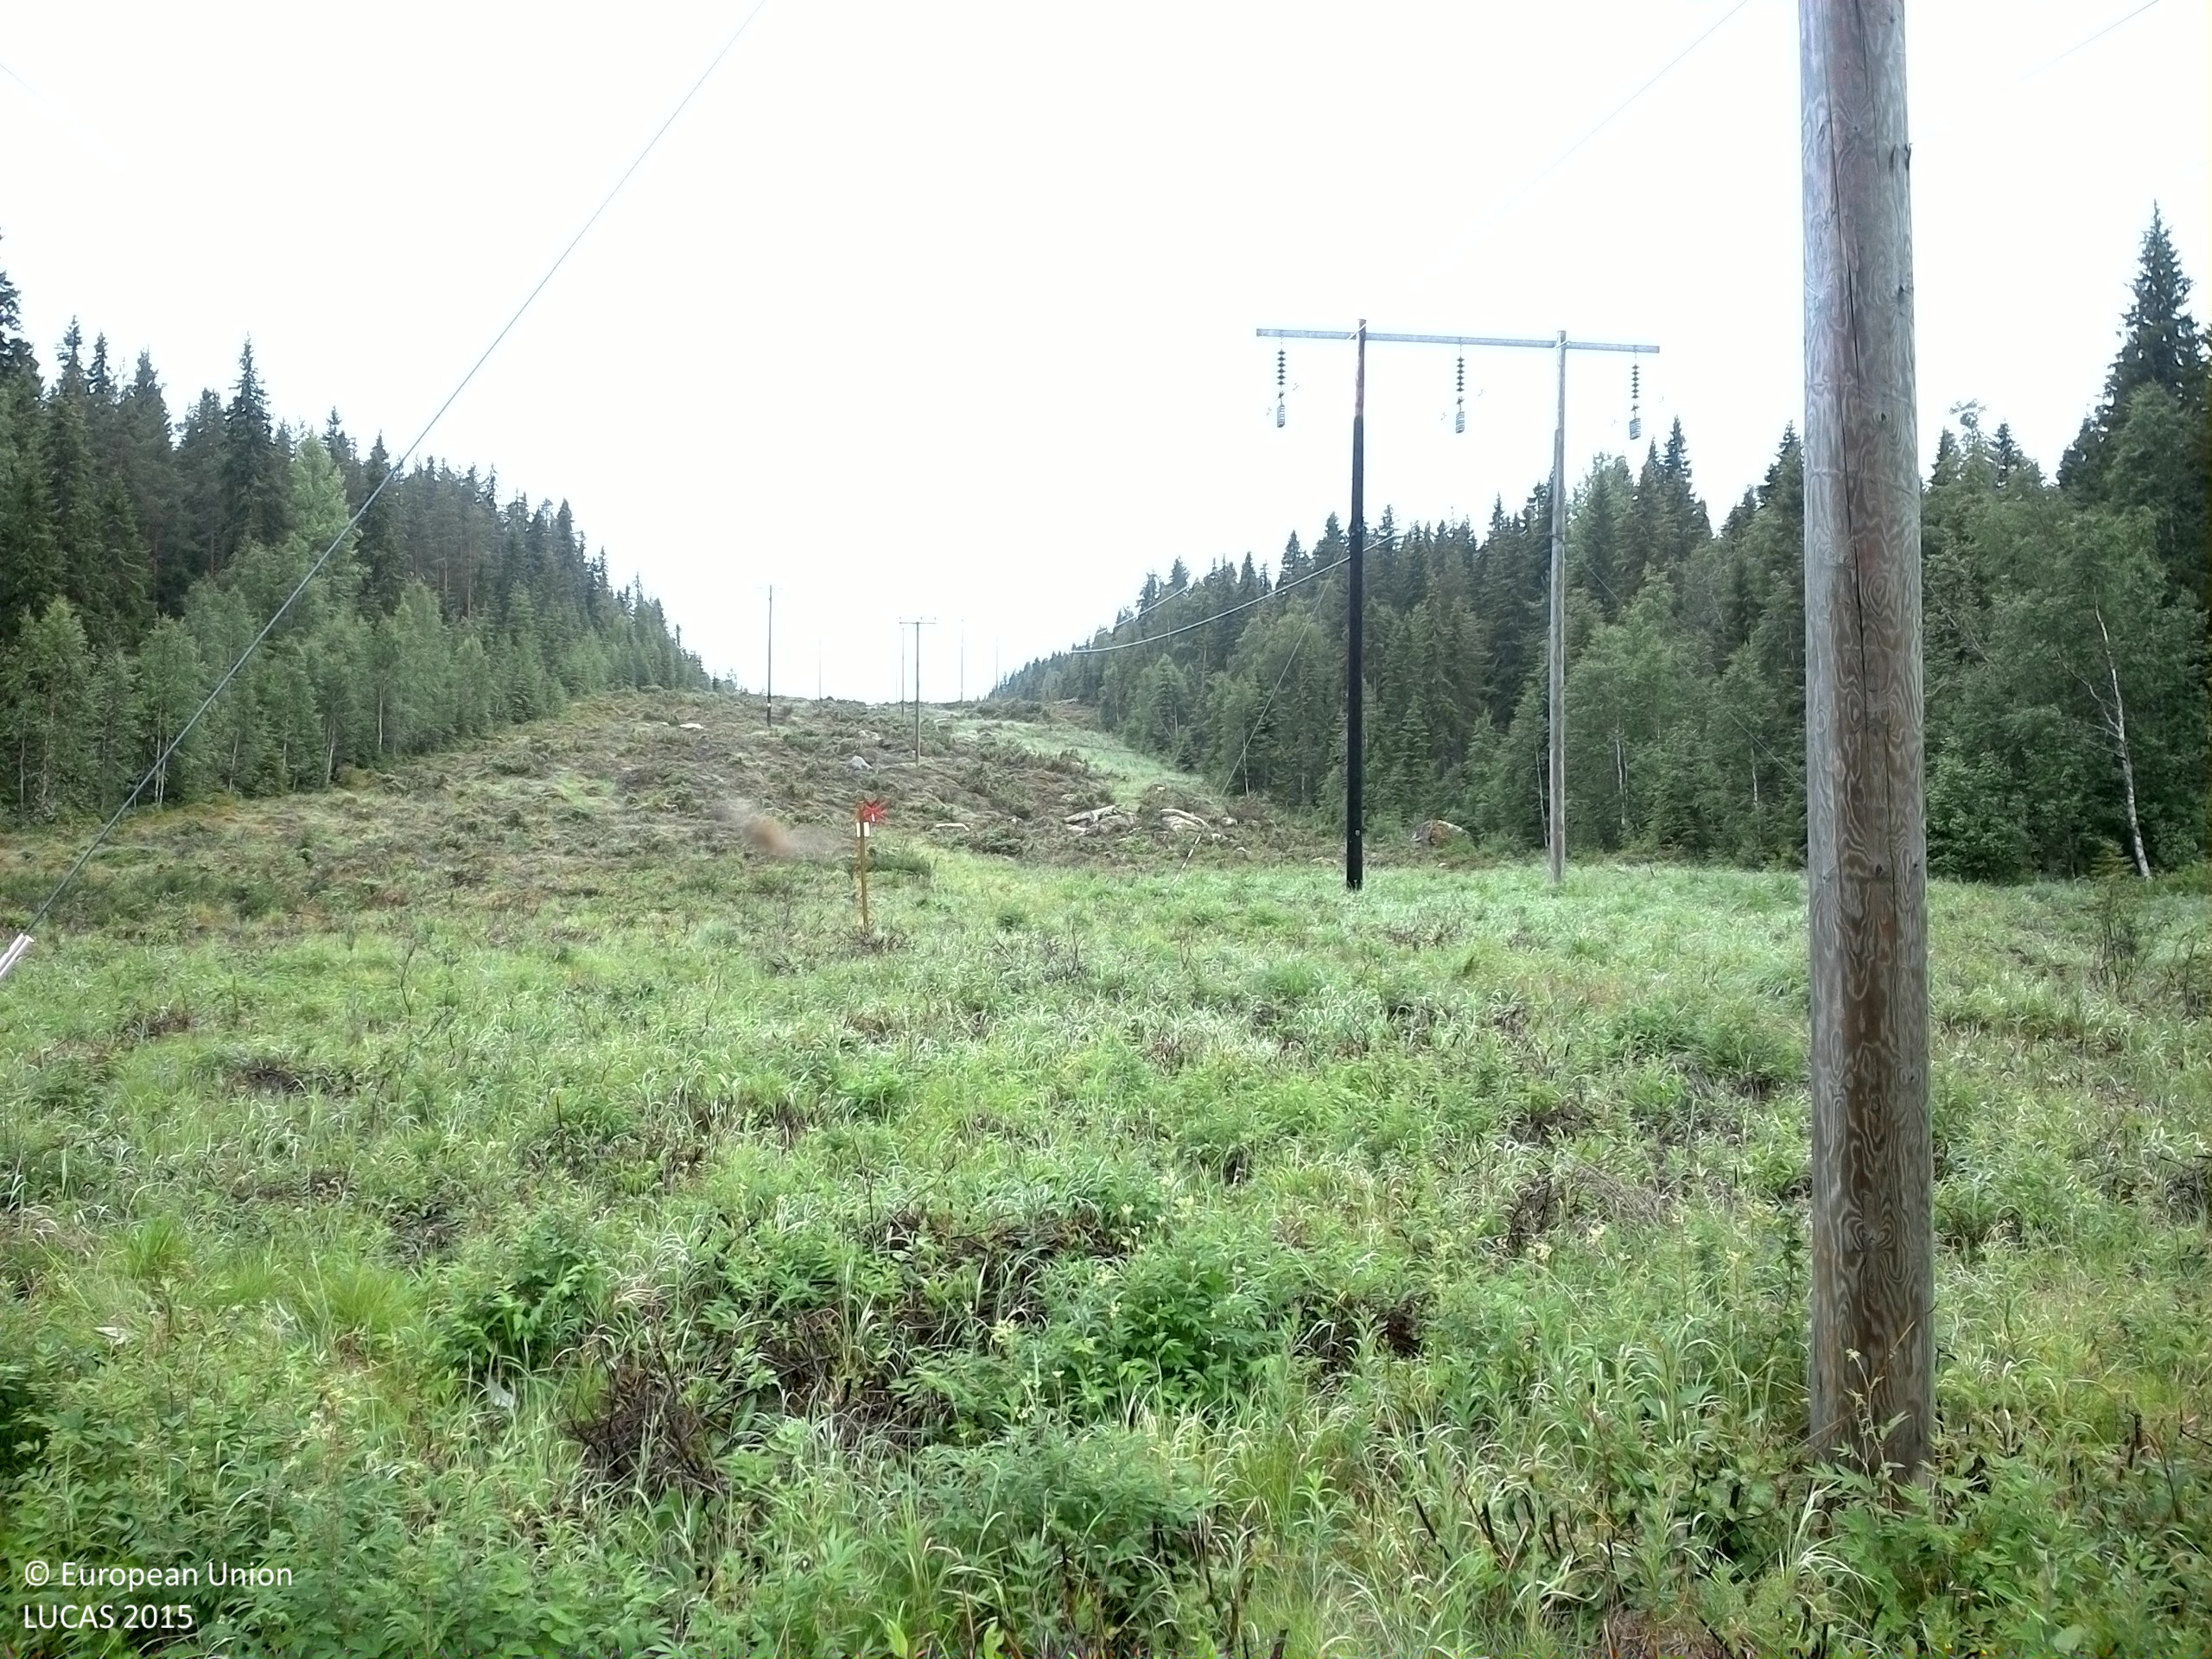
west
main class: Artificial land
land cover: Other artificial areas
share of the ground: 10 - 25 %
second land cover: Shrubland without tree cover
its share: > 75 %
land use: Electricity, gas and thermal power distribution
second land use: Amenities, museums, leisure
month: July
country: SE
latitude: 63.5485
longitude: 18.5679
